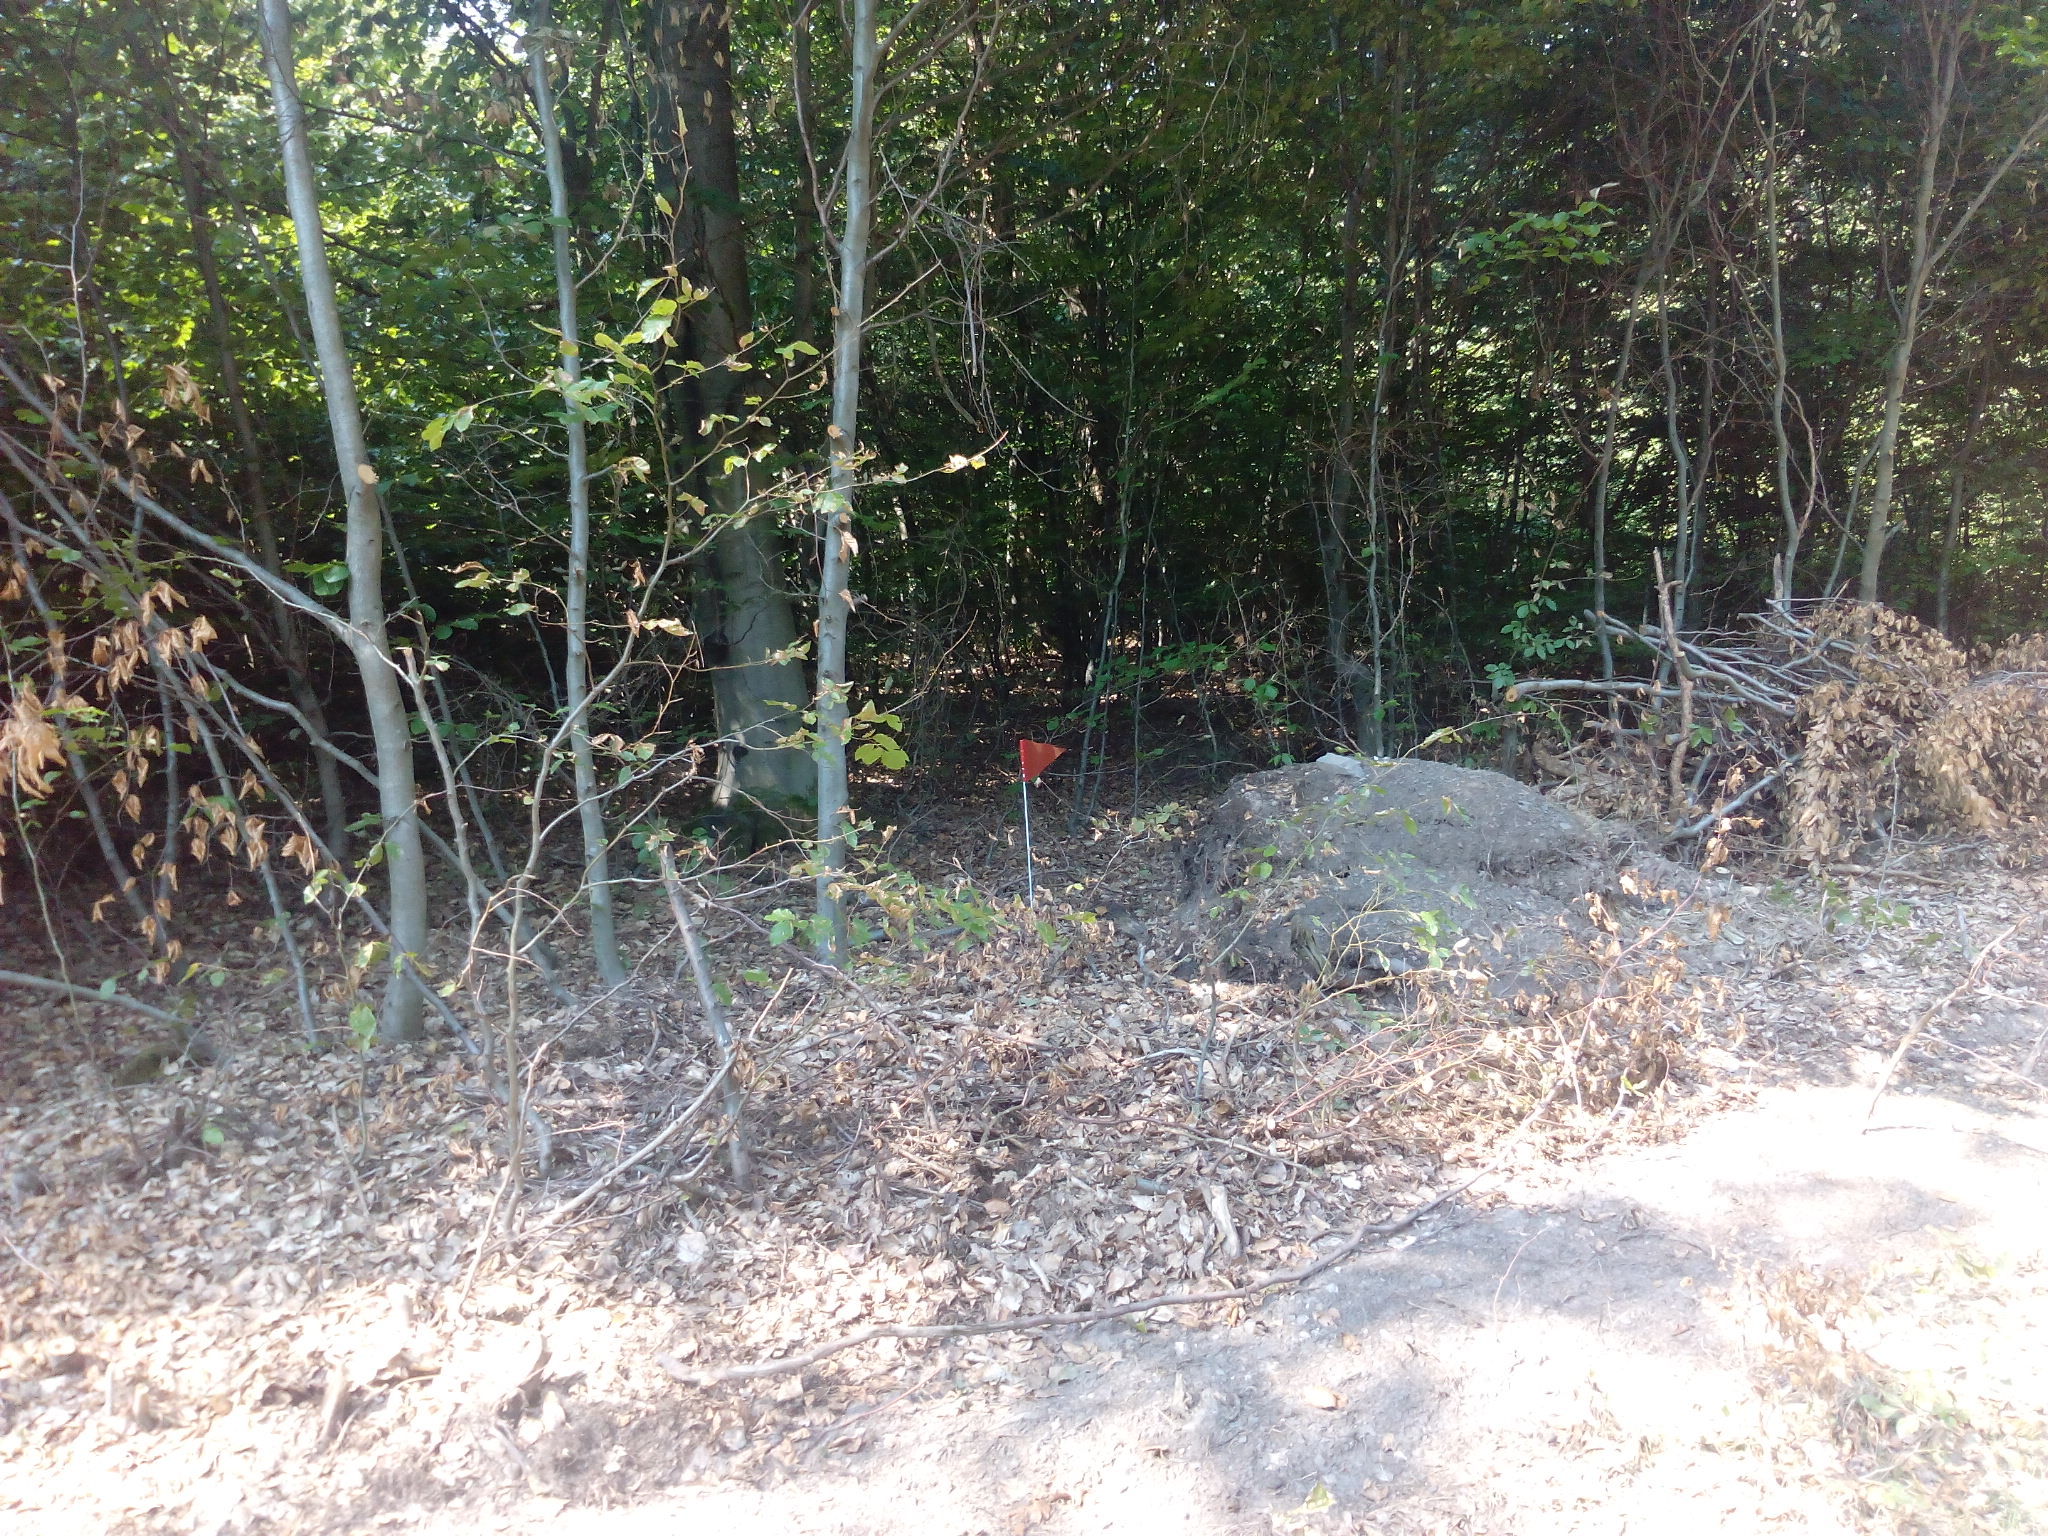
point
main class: Woodland
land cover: Broadleaved woodland
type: beech forest
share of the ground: > 75 %
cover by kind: broadleaved forest trees 90 %, consolidated bare surface 10 %
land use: Forestry
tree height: > 5 m
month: August
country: DE
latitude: 49.7614
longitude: 7.5154
